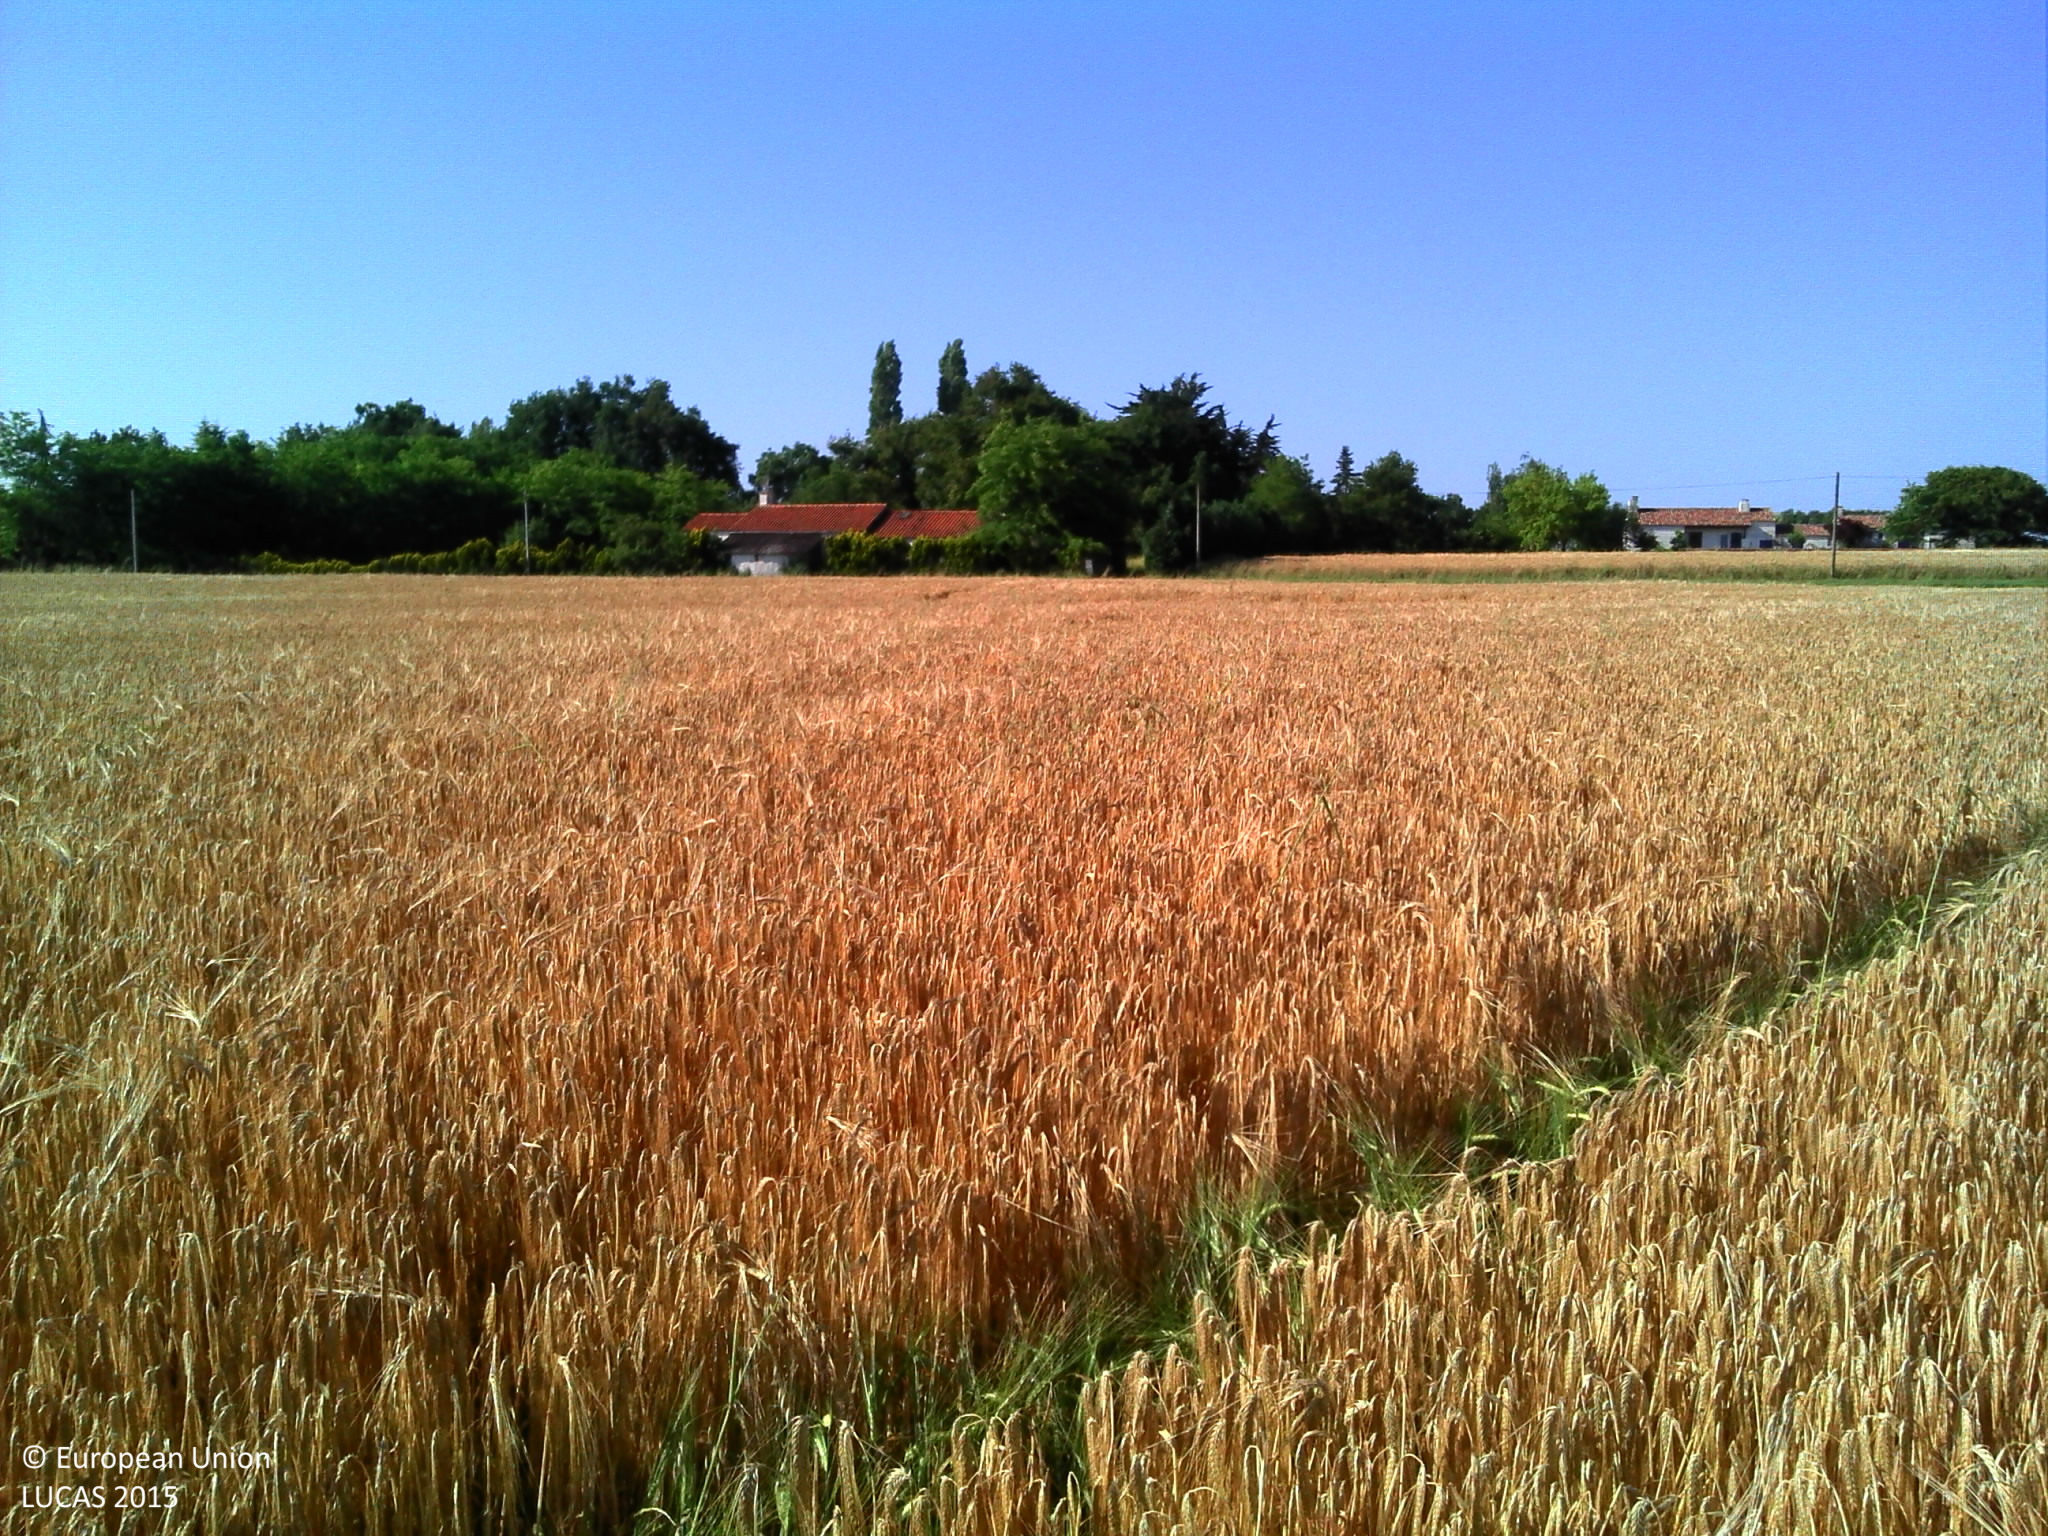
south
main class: Cropland
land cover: Barley
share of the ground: > 75 %
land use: Agriculture (excluding fallow land and kitchen gardens)
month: June
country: FR
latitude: 46.9653
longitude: -1.8335
